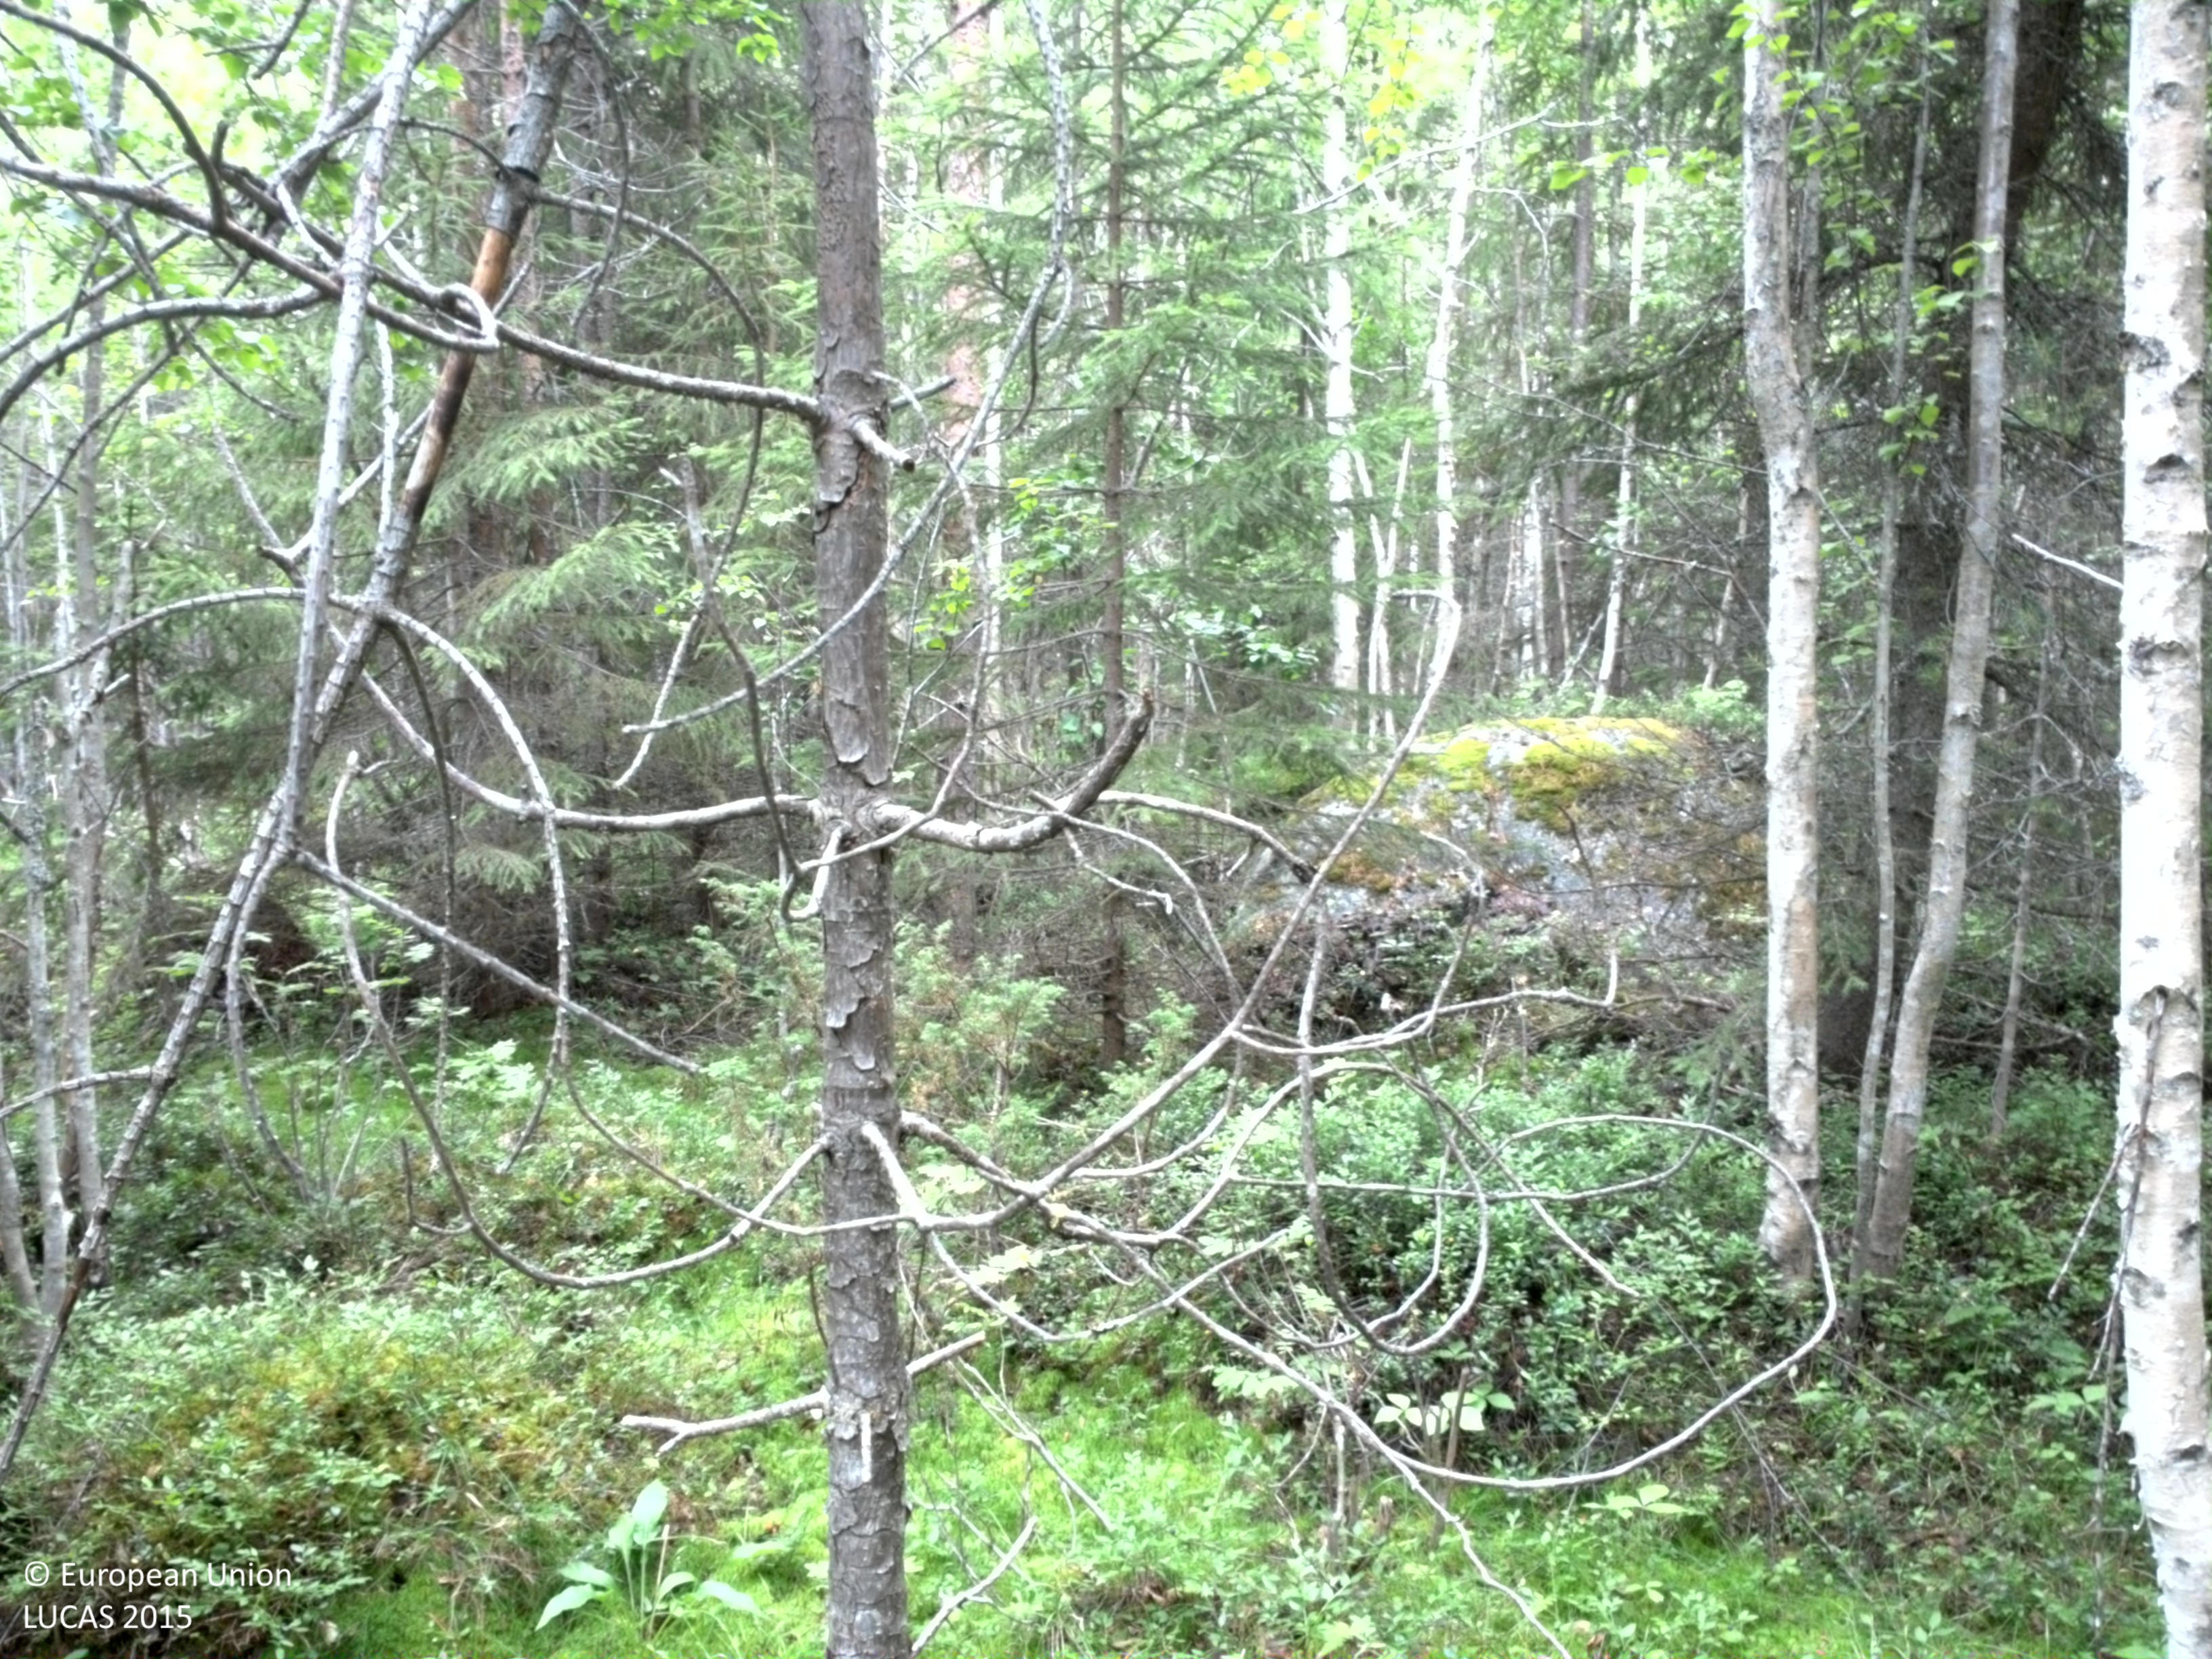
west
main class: Woodland
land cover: Spruce dominated mixed woodland
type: boreal forest
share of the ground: > 75 %
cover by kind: coniferous forest trees 60 %, broadleaved forest trees 20 %, shrubs 10 %, herbaceous plants 5 %, lichens and mosses 5 %
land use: Forestry
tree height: > 5 m
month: August
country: SE
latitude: 64.6619
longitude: 20.8894
